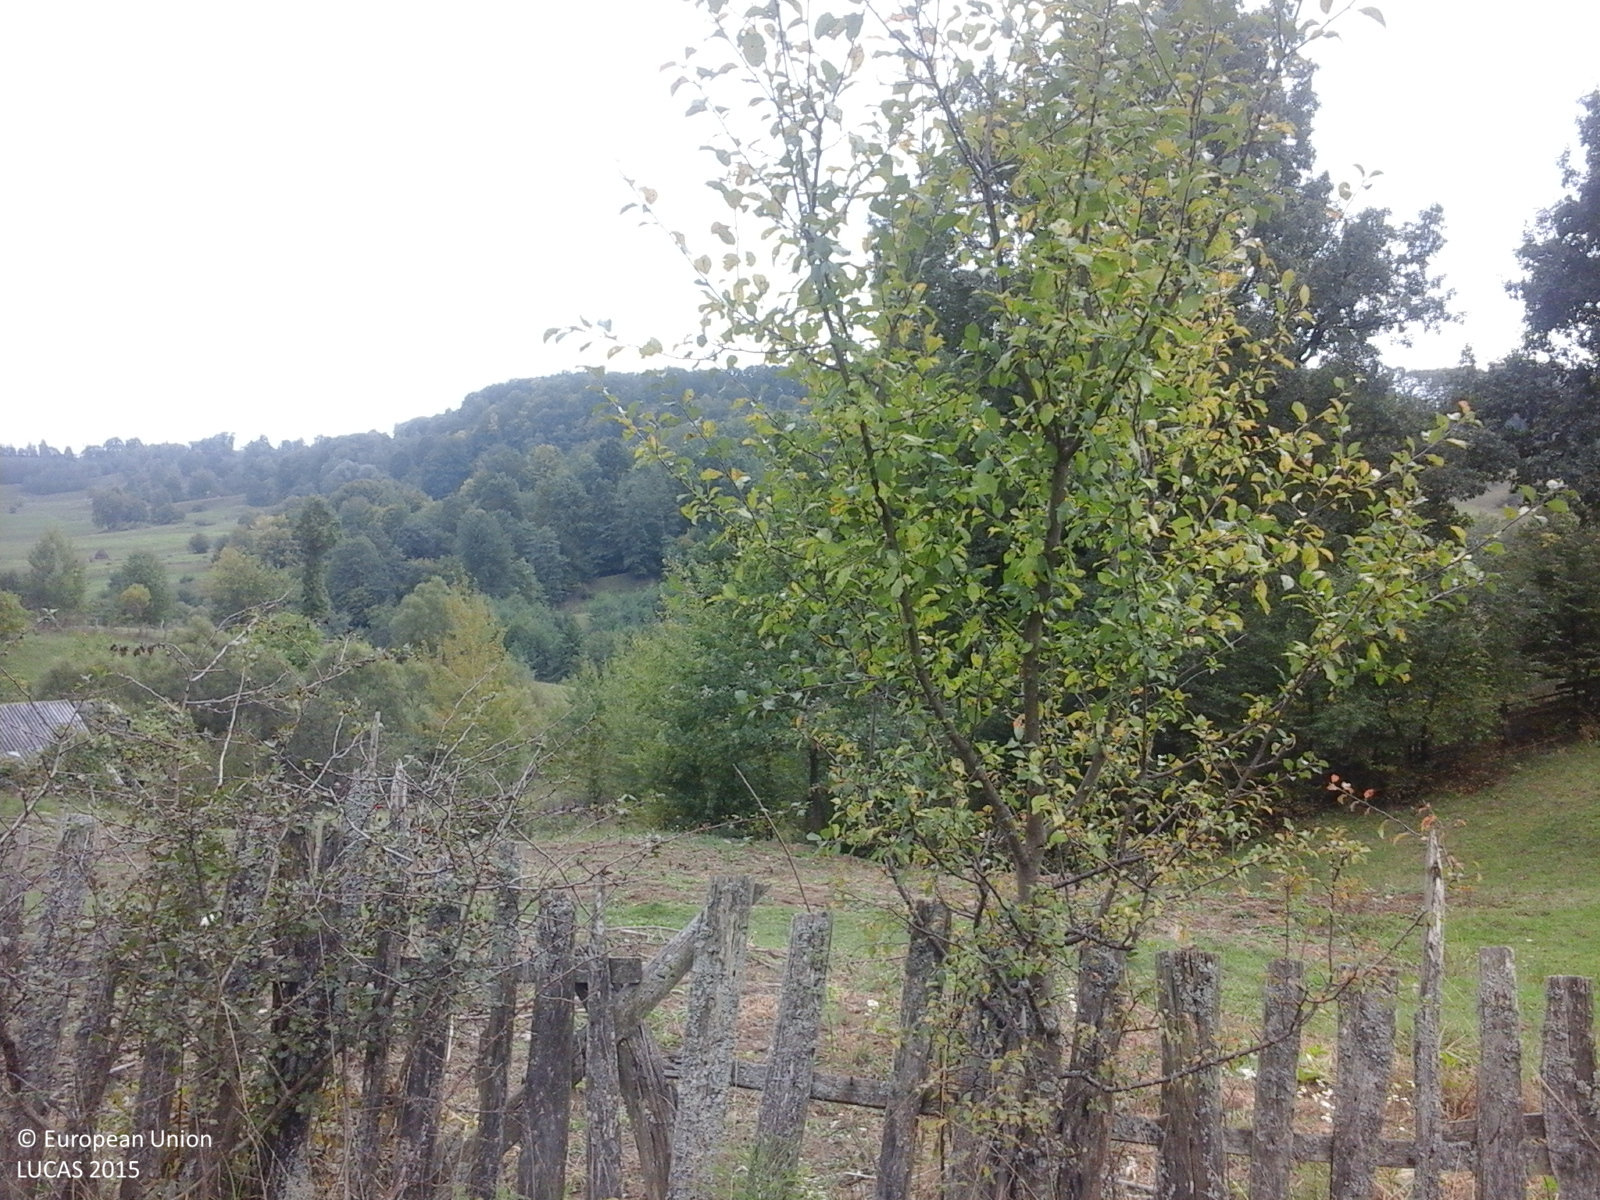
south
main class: Grassland
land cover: Spontaneously vegetated surfaces
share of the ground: > 75 %
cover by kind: herbaceous plants 100 %
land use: Fallow land
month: October
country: RO
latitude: 46.8164
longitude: 24.9213
